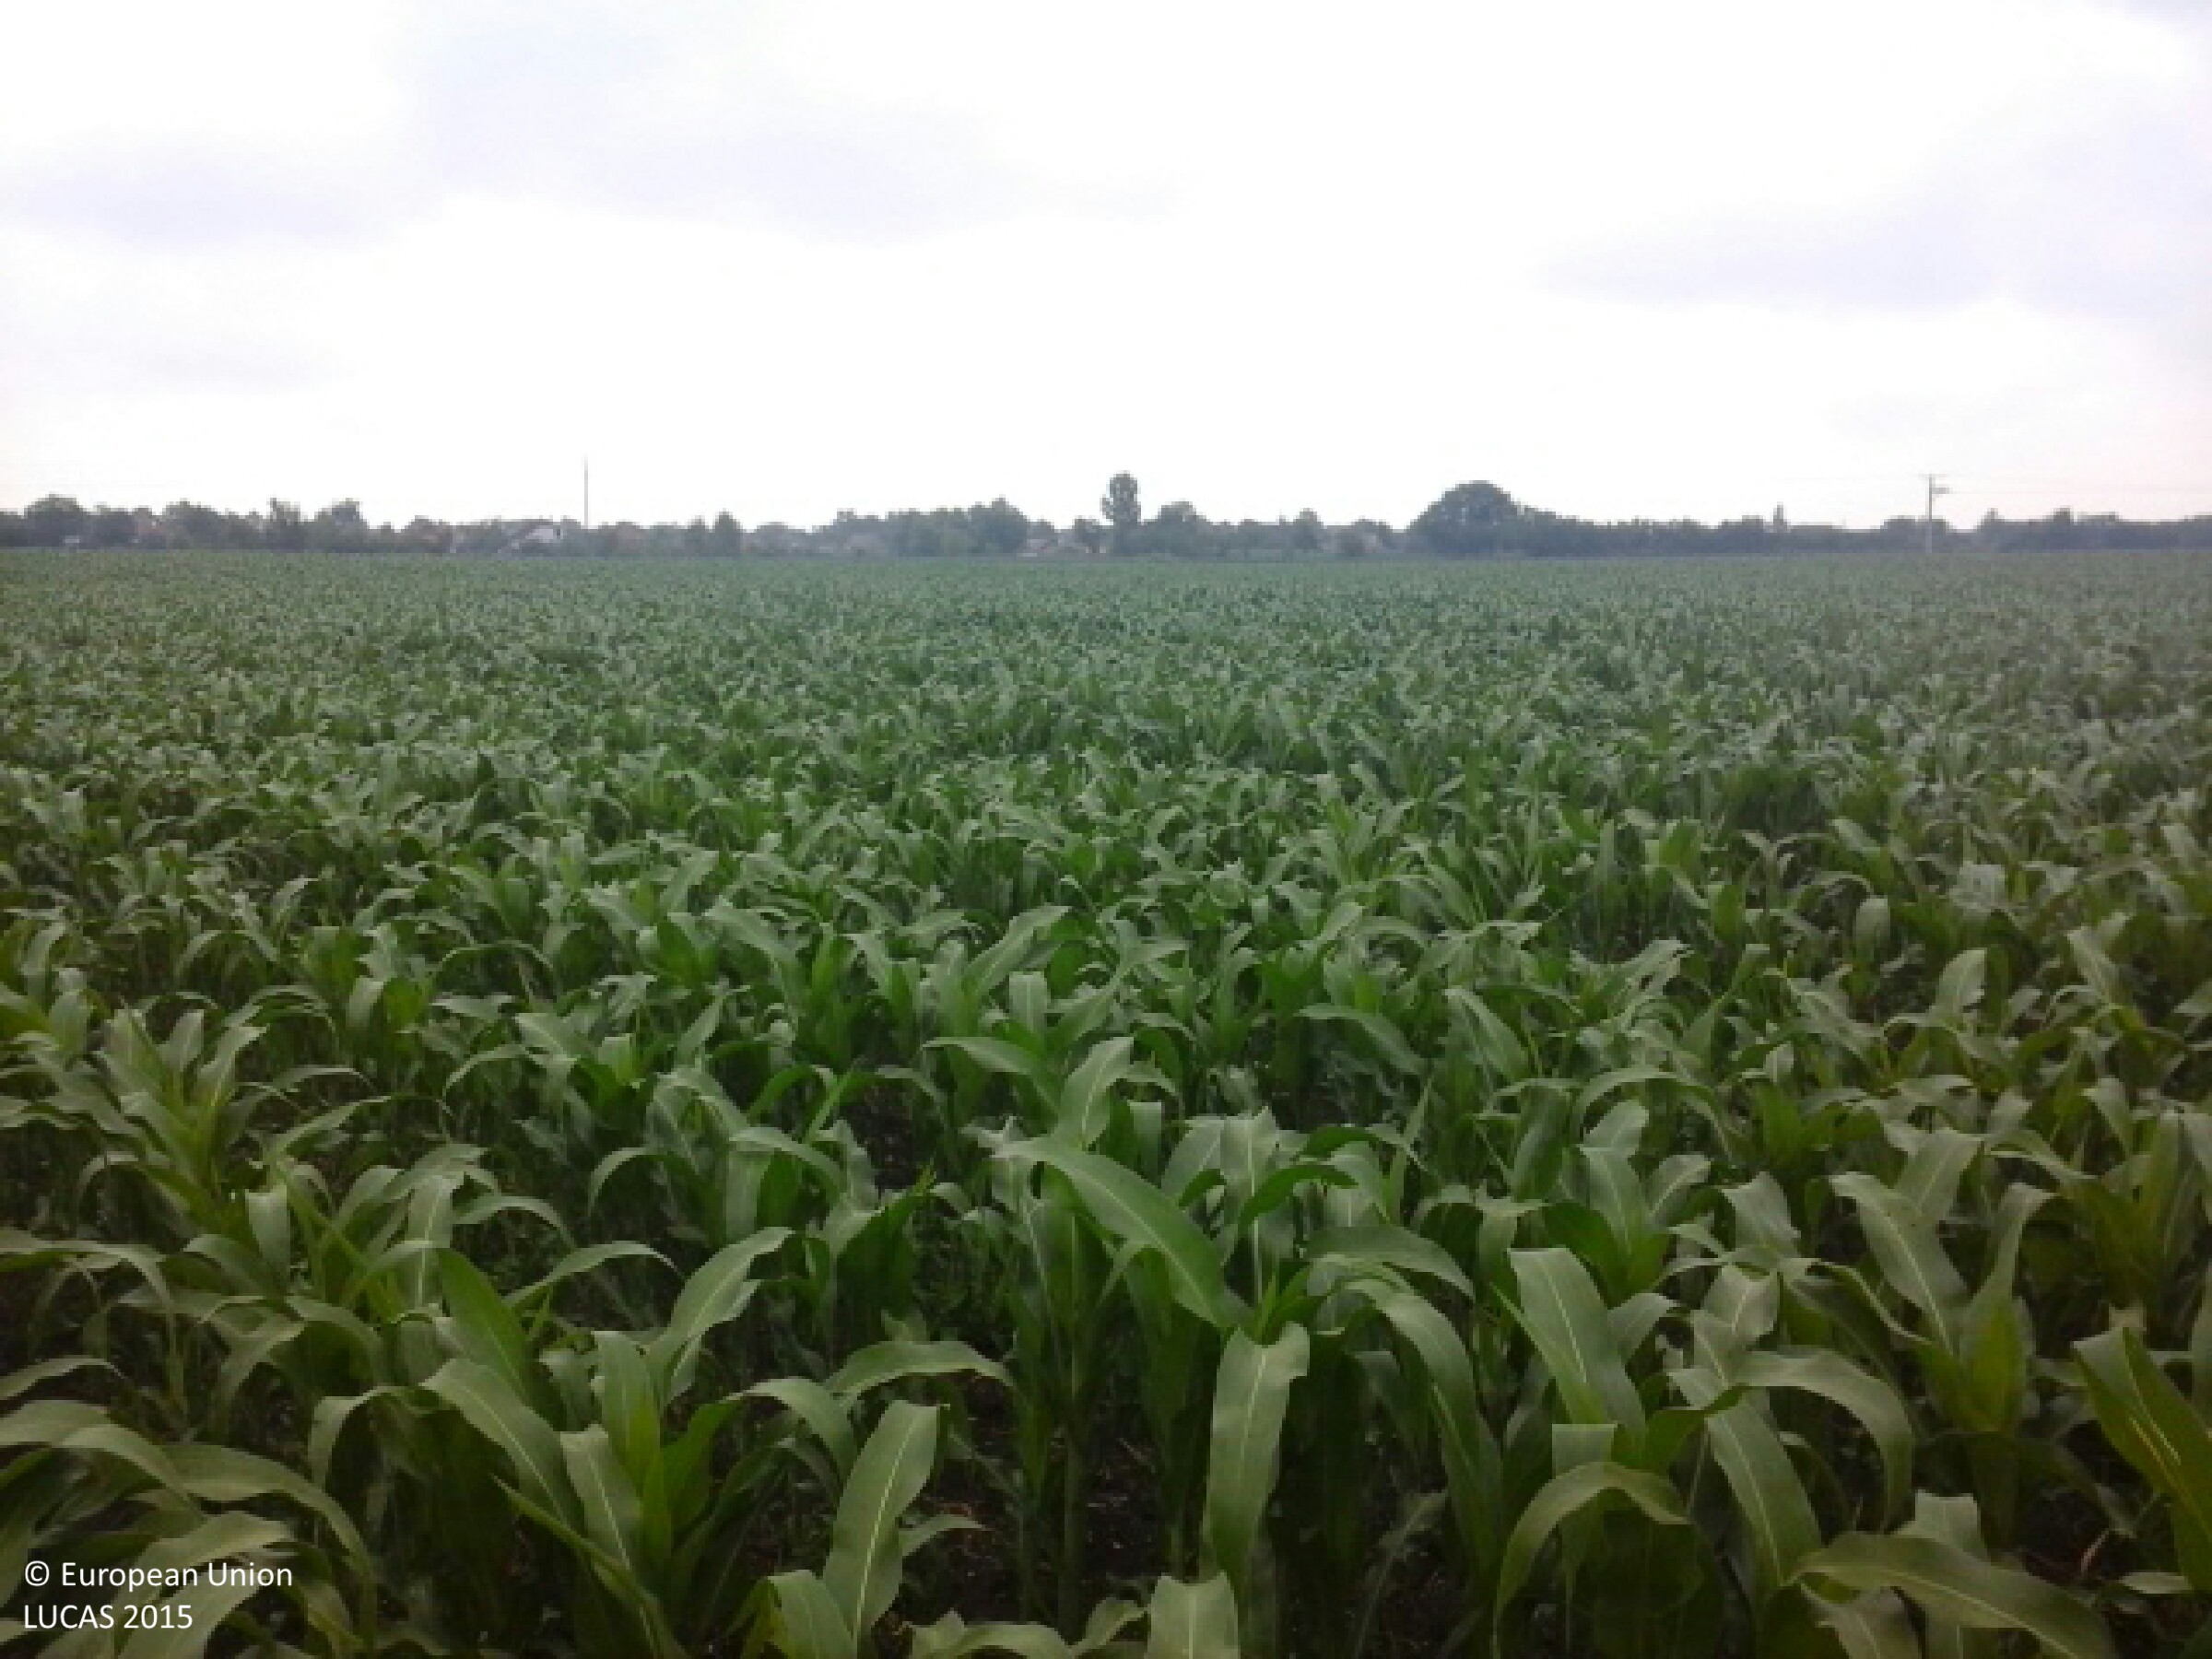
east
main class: Cropland
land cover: Maize
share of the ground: 50 - 75 %
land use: Agriculture (excluding fallow land and kitchen gardens)
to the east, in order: Maize; Electric lines; Maize; Grass margins; Tracks; Grass margins; Inland fresh running water; Grass margins; Maize
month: June
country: HU
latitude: 48.1143
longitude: 21.8029
